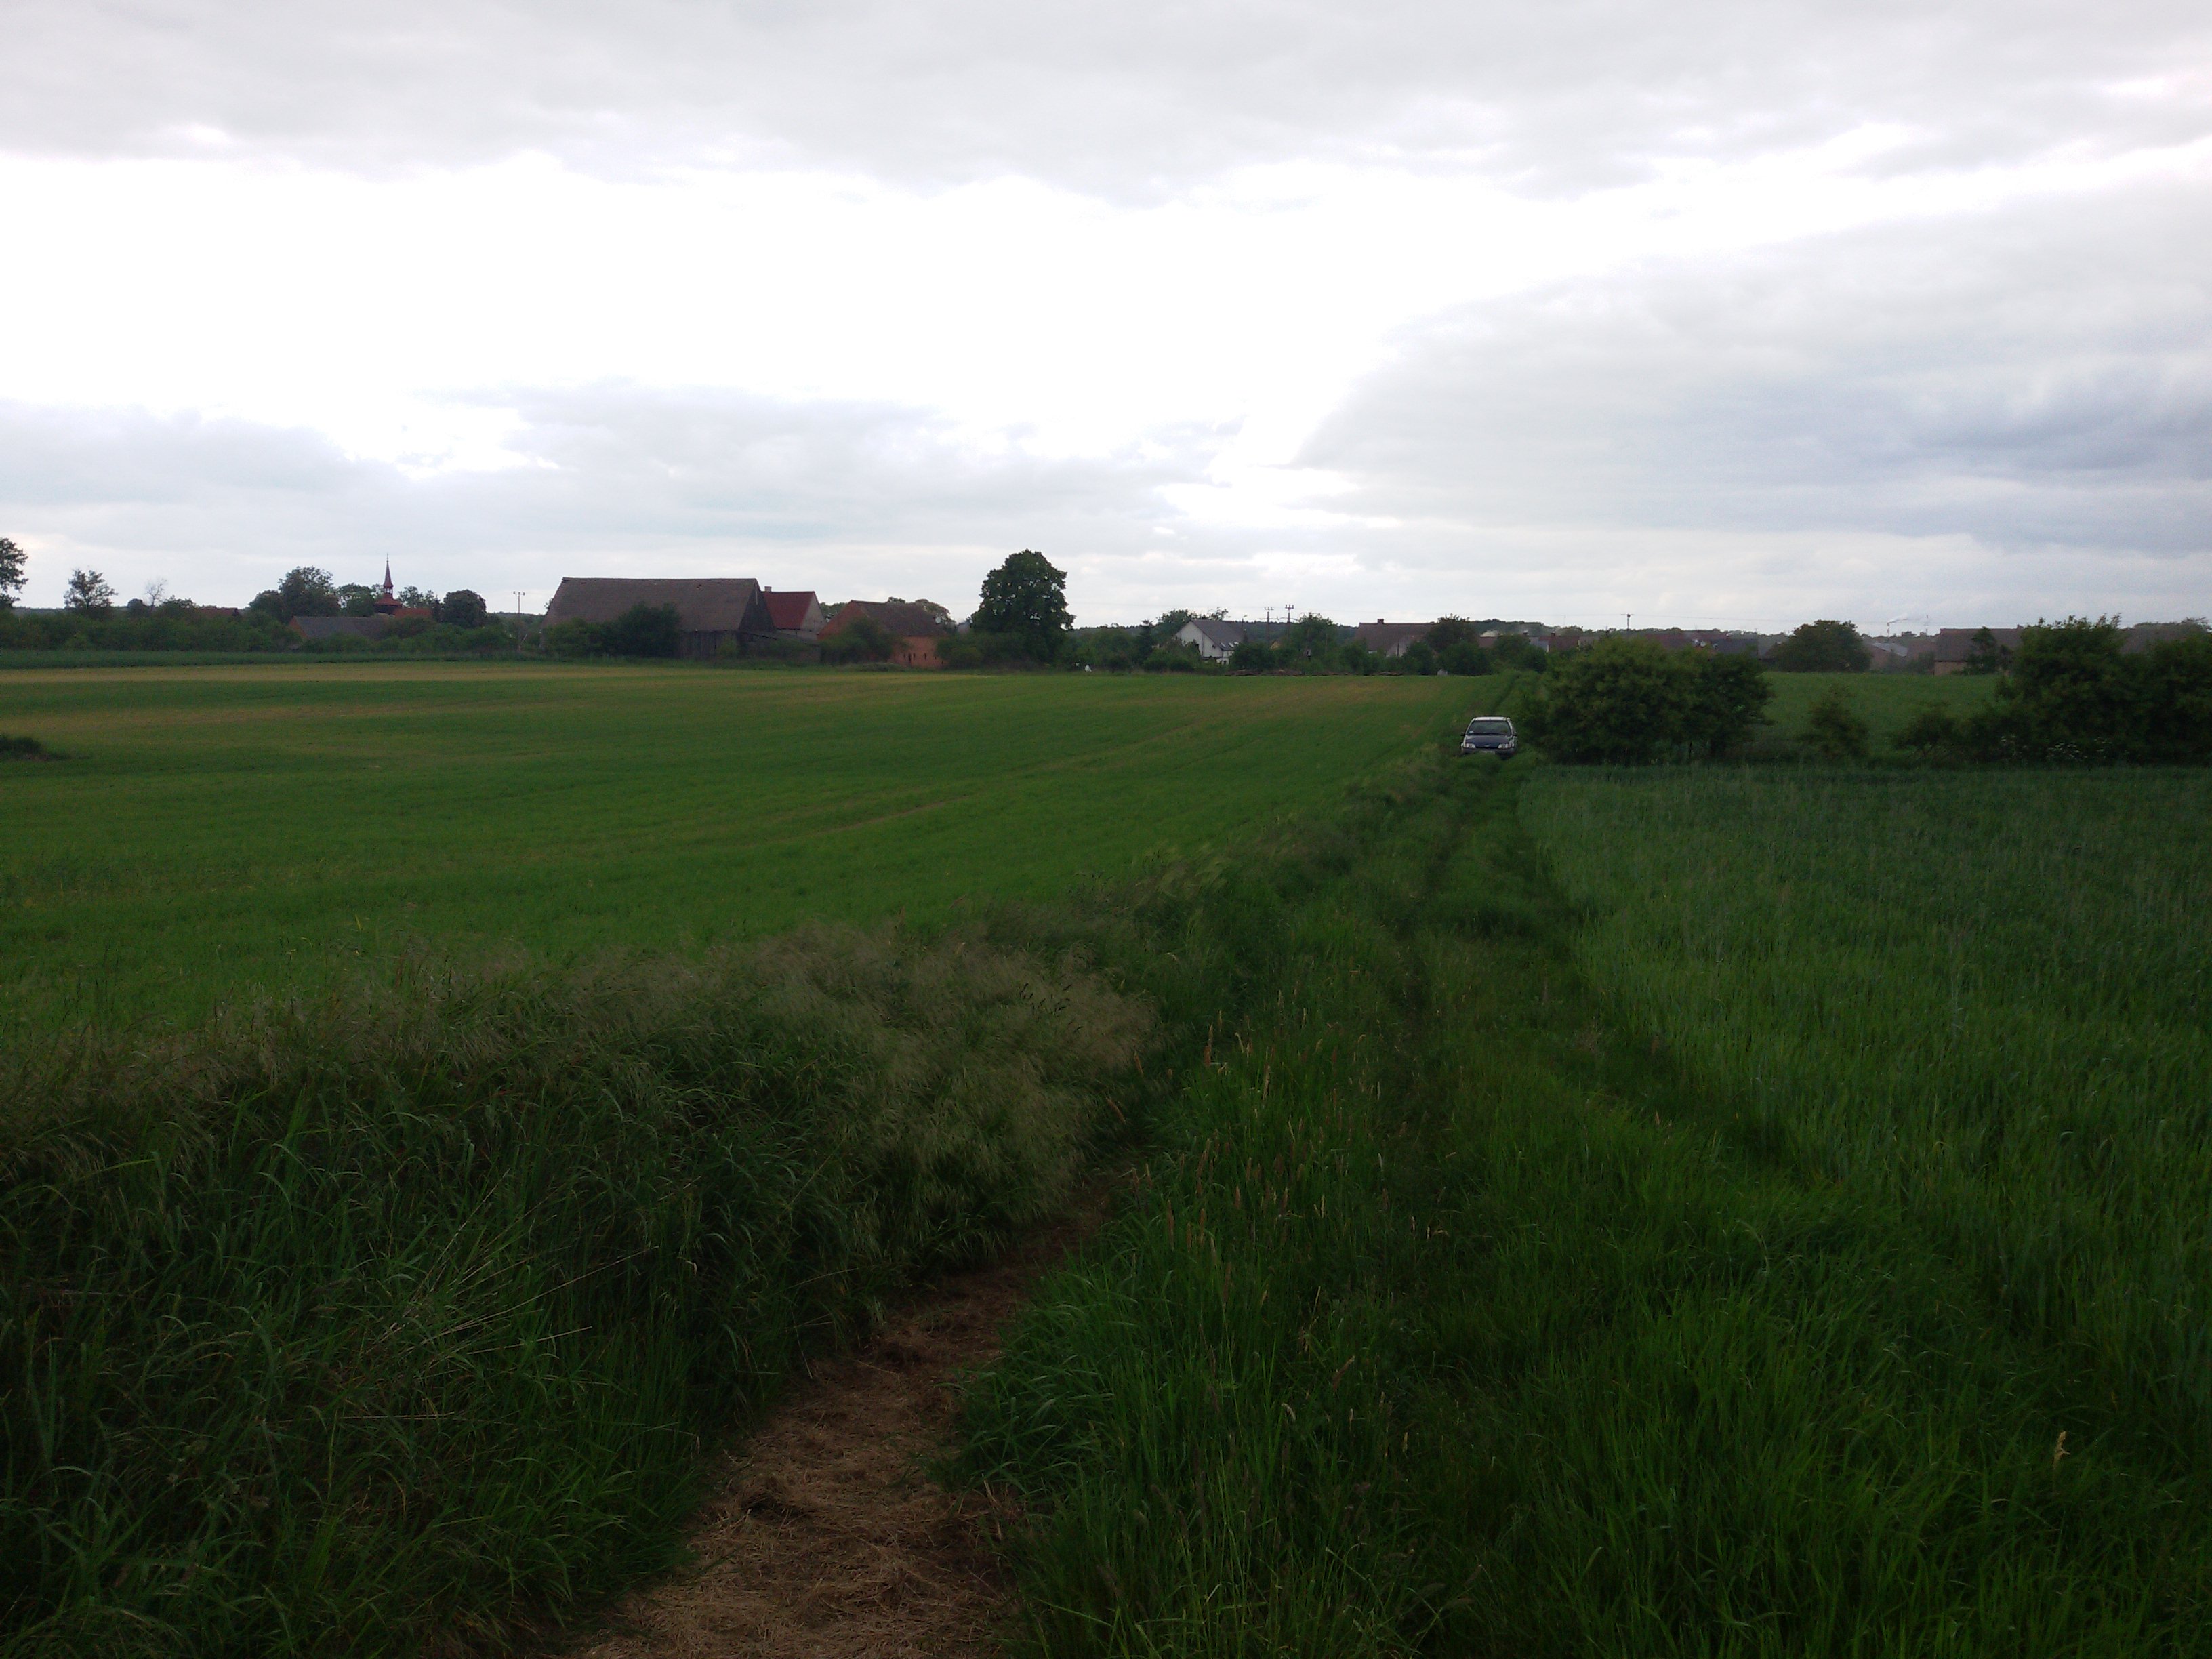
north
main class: Cropland
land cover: Rye
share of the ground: > 75 %
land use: Agriculture (excluding fallow land and kitchen gardens)
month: May
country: PL
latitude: 53.0856
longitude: 14.4654
